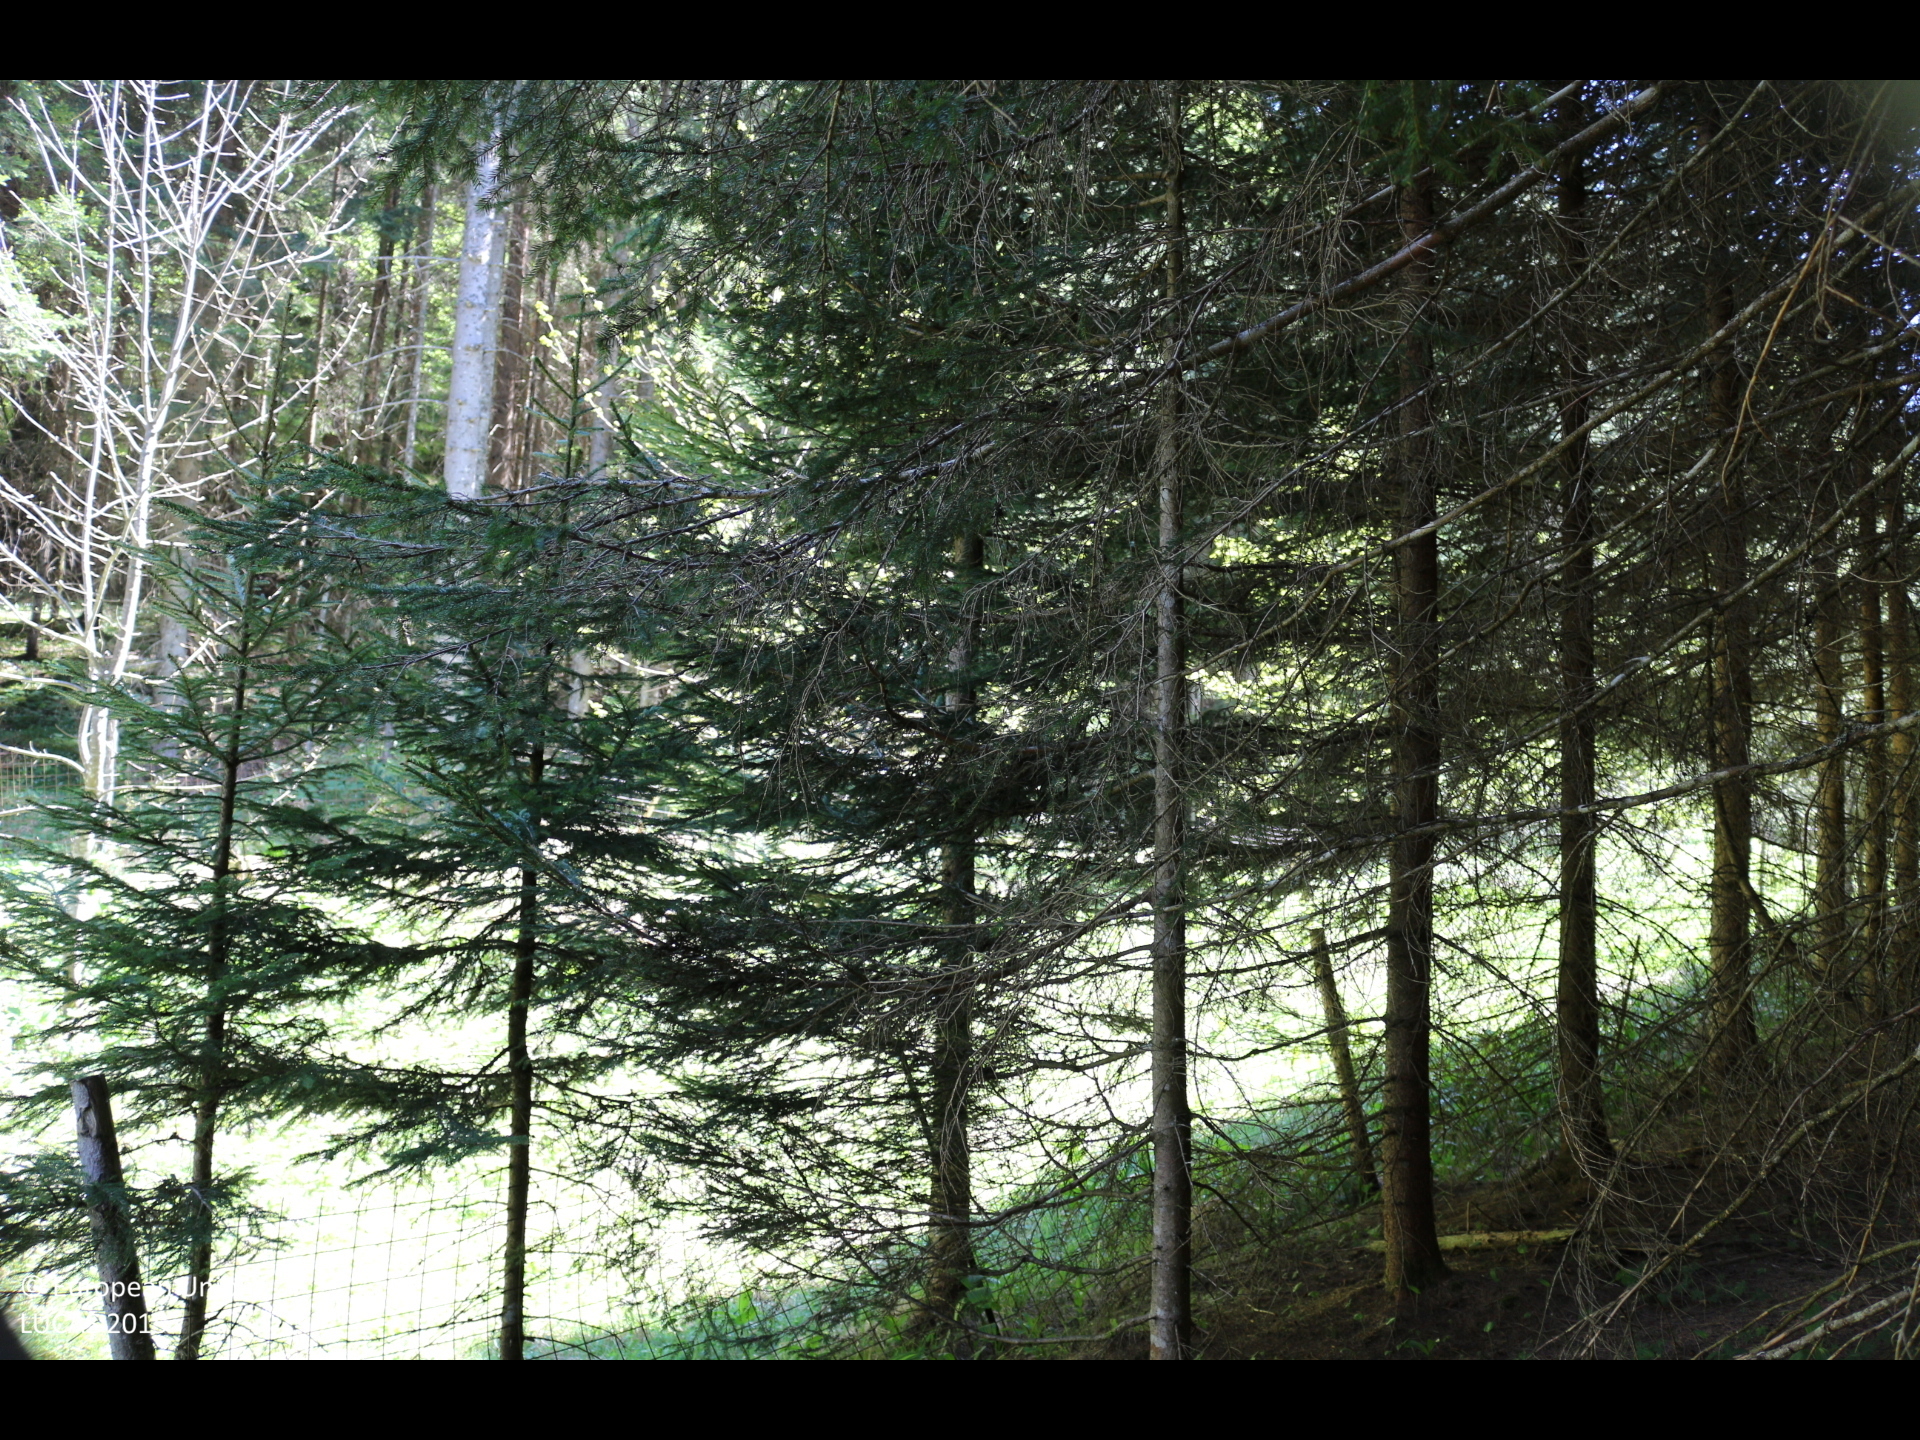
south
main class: Woodland
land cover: Spruce dominated coniferous woodland
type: alpine coniferous forest
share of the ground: > 75 %
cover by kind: coniferous forest trees 95 %, broadleaved forest trees 5 %
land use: Forestry
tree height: > 5 m
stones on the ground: < 10 %
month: May
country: AT
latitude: 46.4850
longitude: 14.2048
